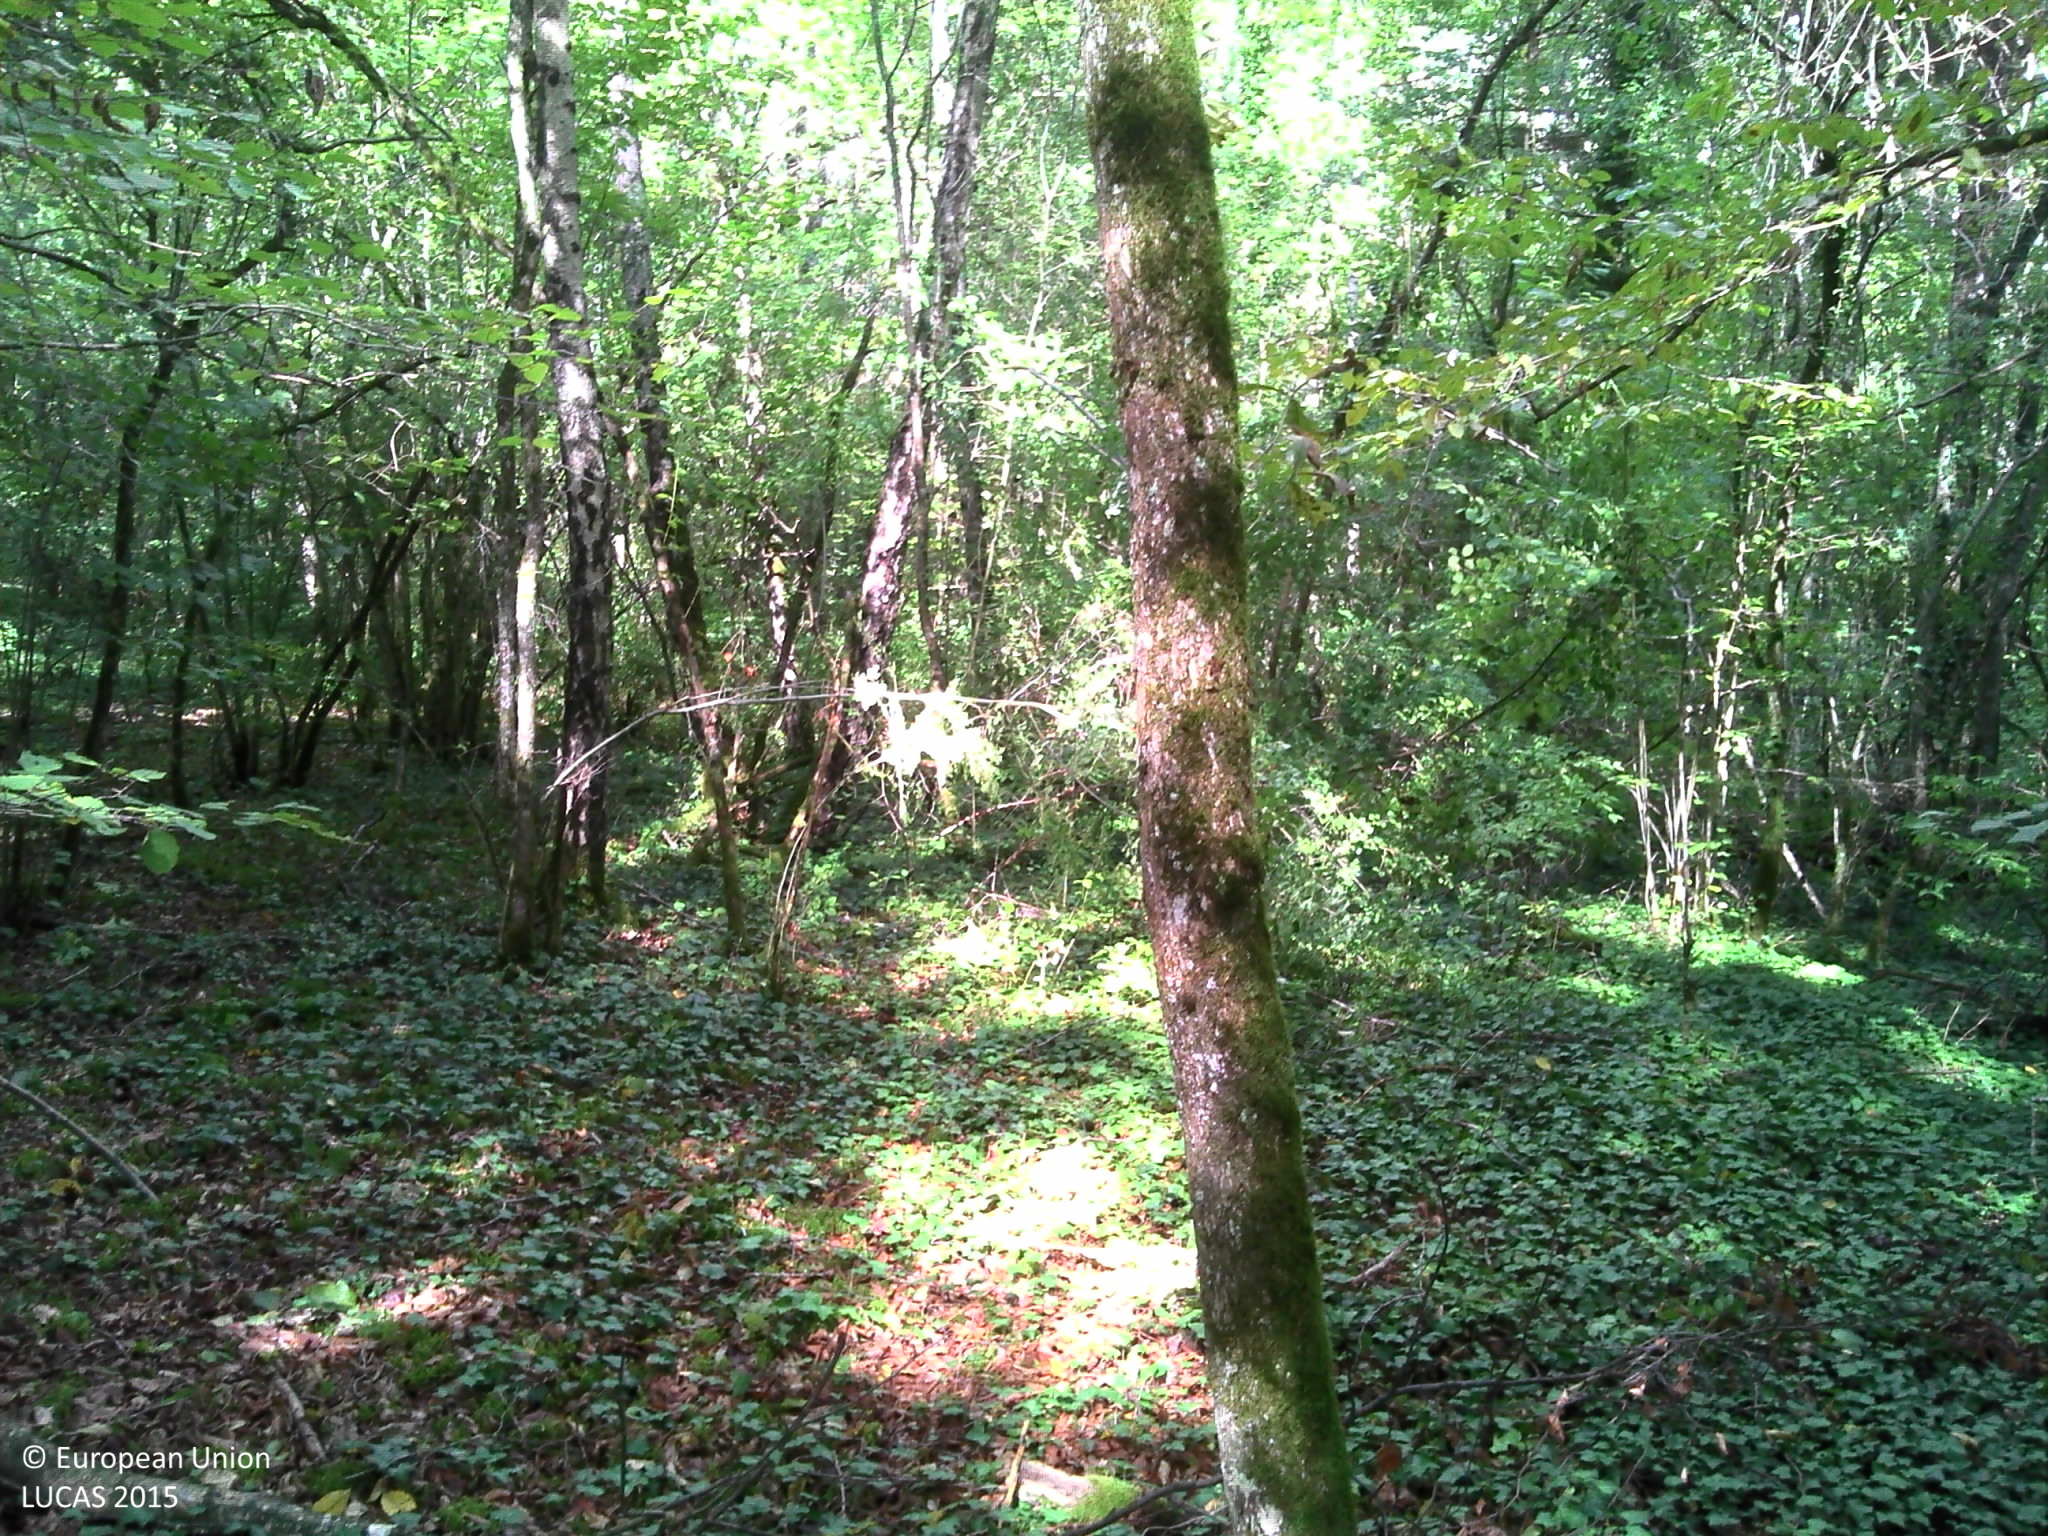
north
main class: Woodland
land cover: Broadleaved woodland
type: mesophytic deciduous forest
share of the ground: > 75 %
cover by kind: broadleaved forest trees 90 %, herbaceous plants 5 %, lichens and mosses 5 %
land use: Forestry
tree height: > 5 m
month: September
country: FR
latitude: 48.0205
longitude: 4.2723
